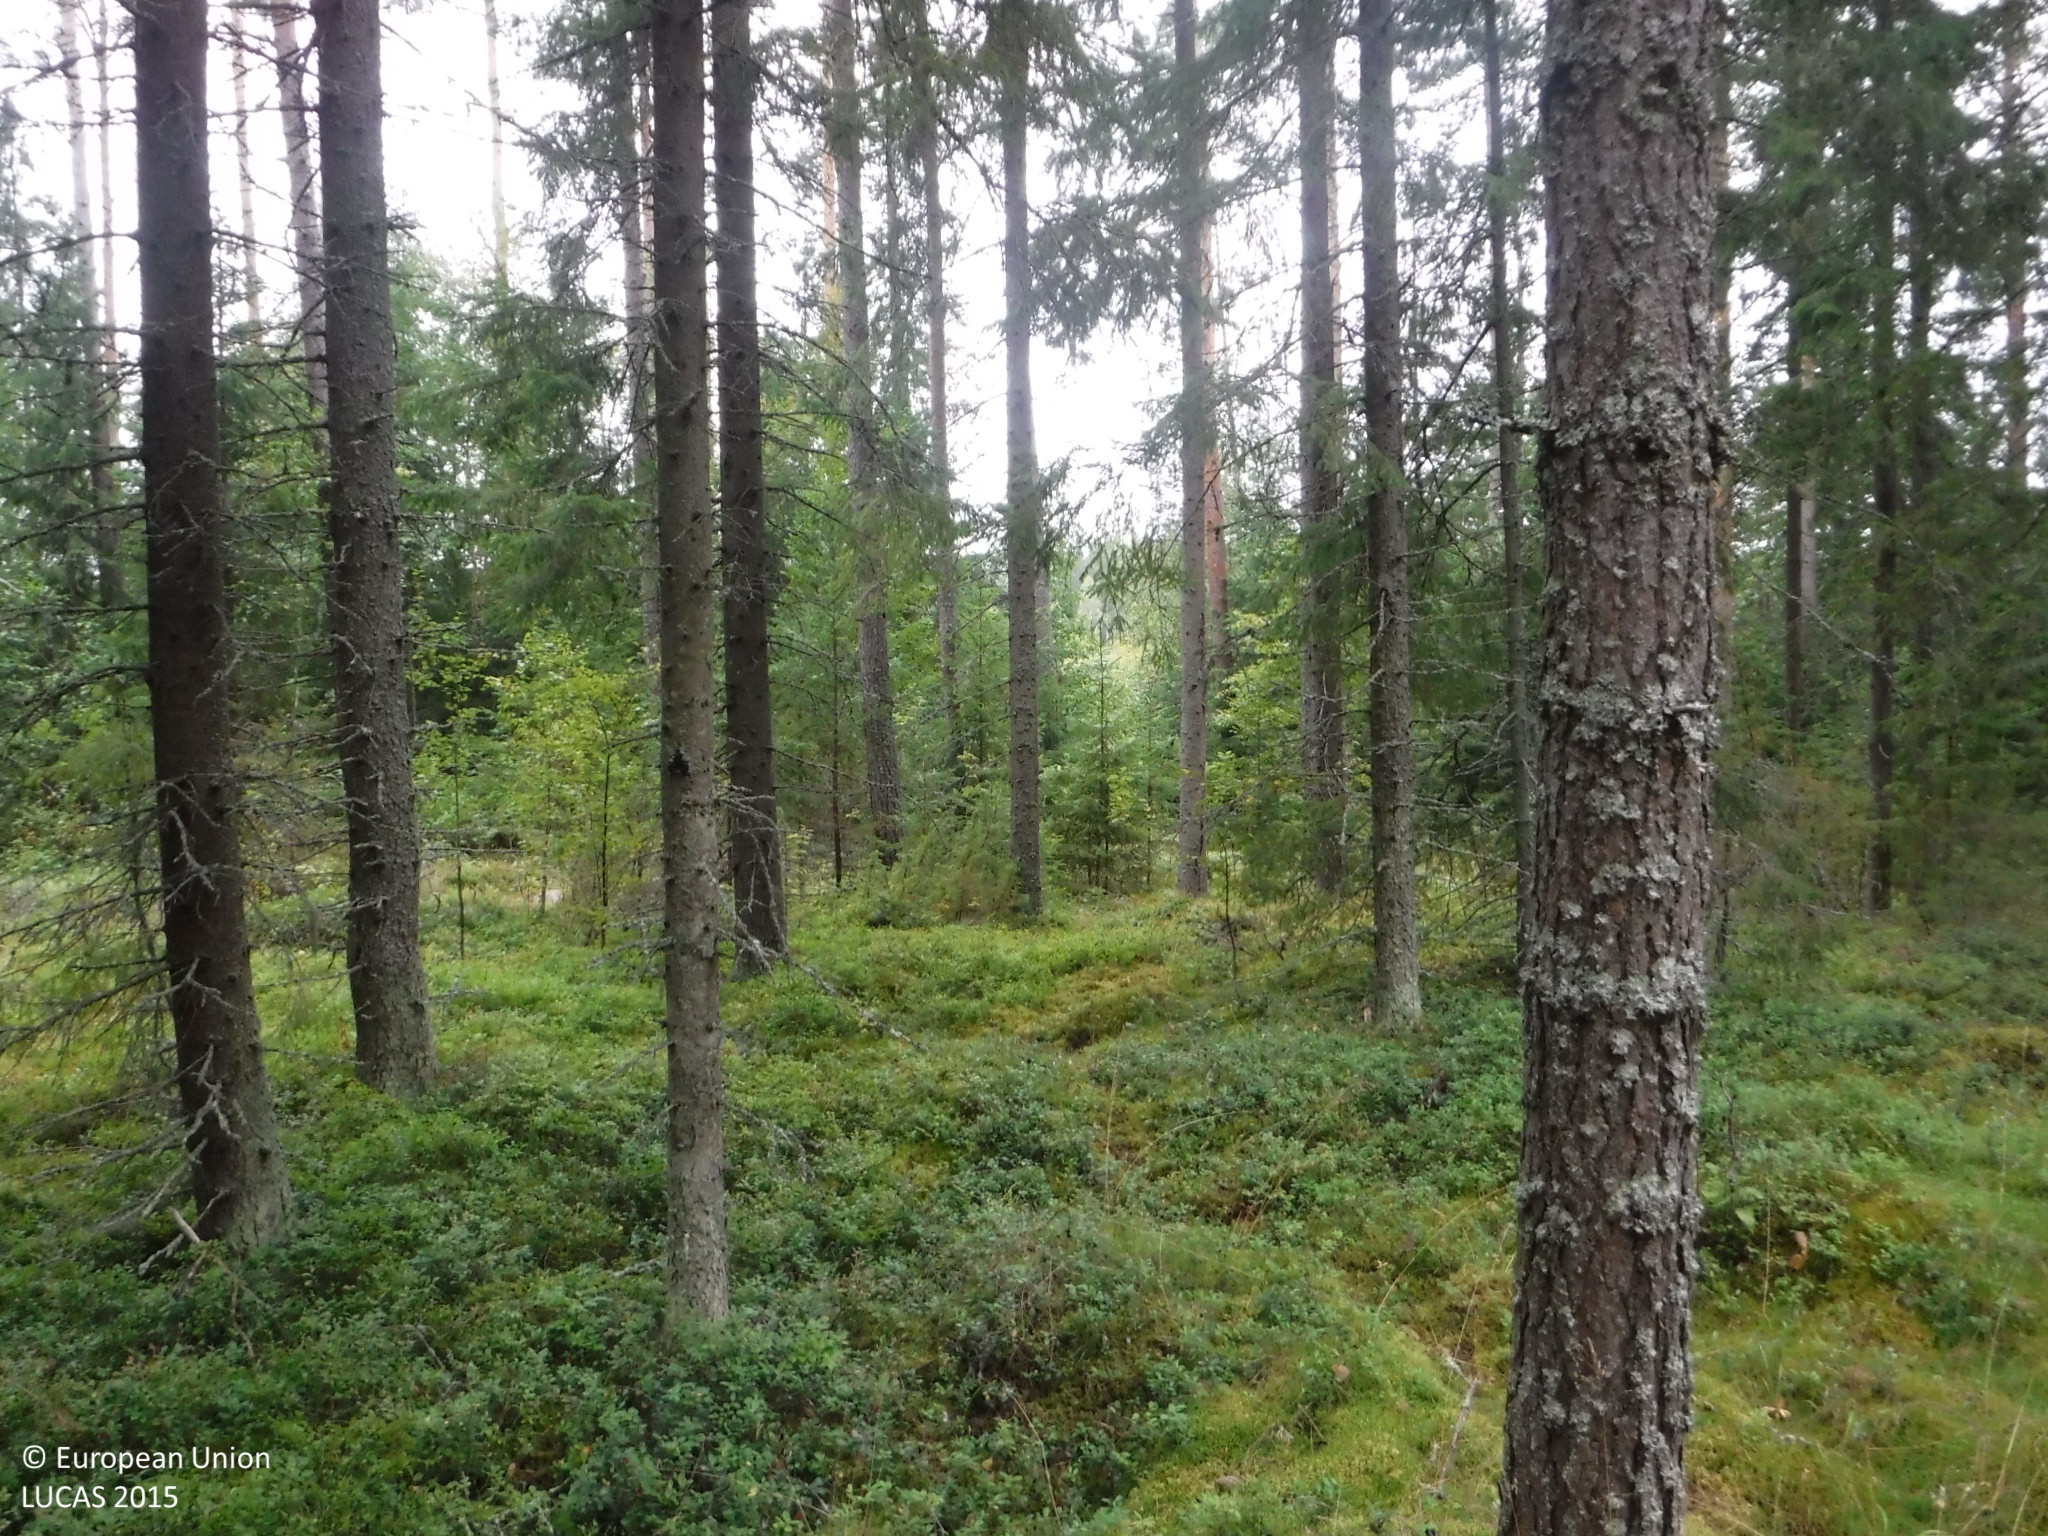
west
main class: Woodland
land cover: Other coniferous woodland
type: boreal forest
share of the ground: 50 - 75 %
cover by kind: coniferous forest trees 50 %, lichens and mosses 25 %, shrubs 20 %, herbaceous plants 5 %
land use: Forestry
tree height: > 5 m
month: September
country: FI
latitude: 61.2508
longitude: 21.5900
